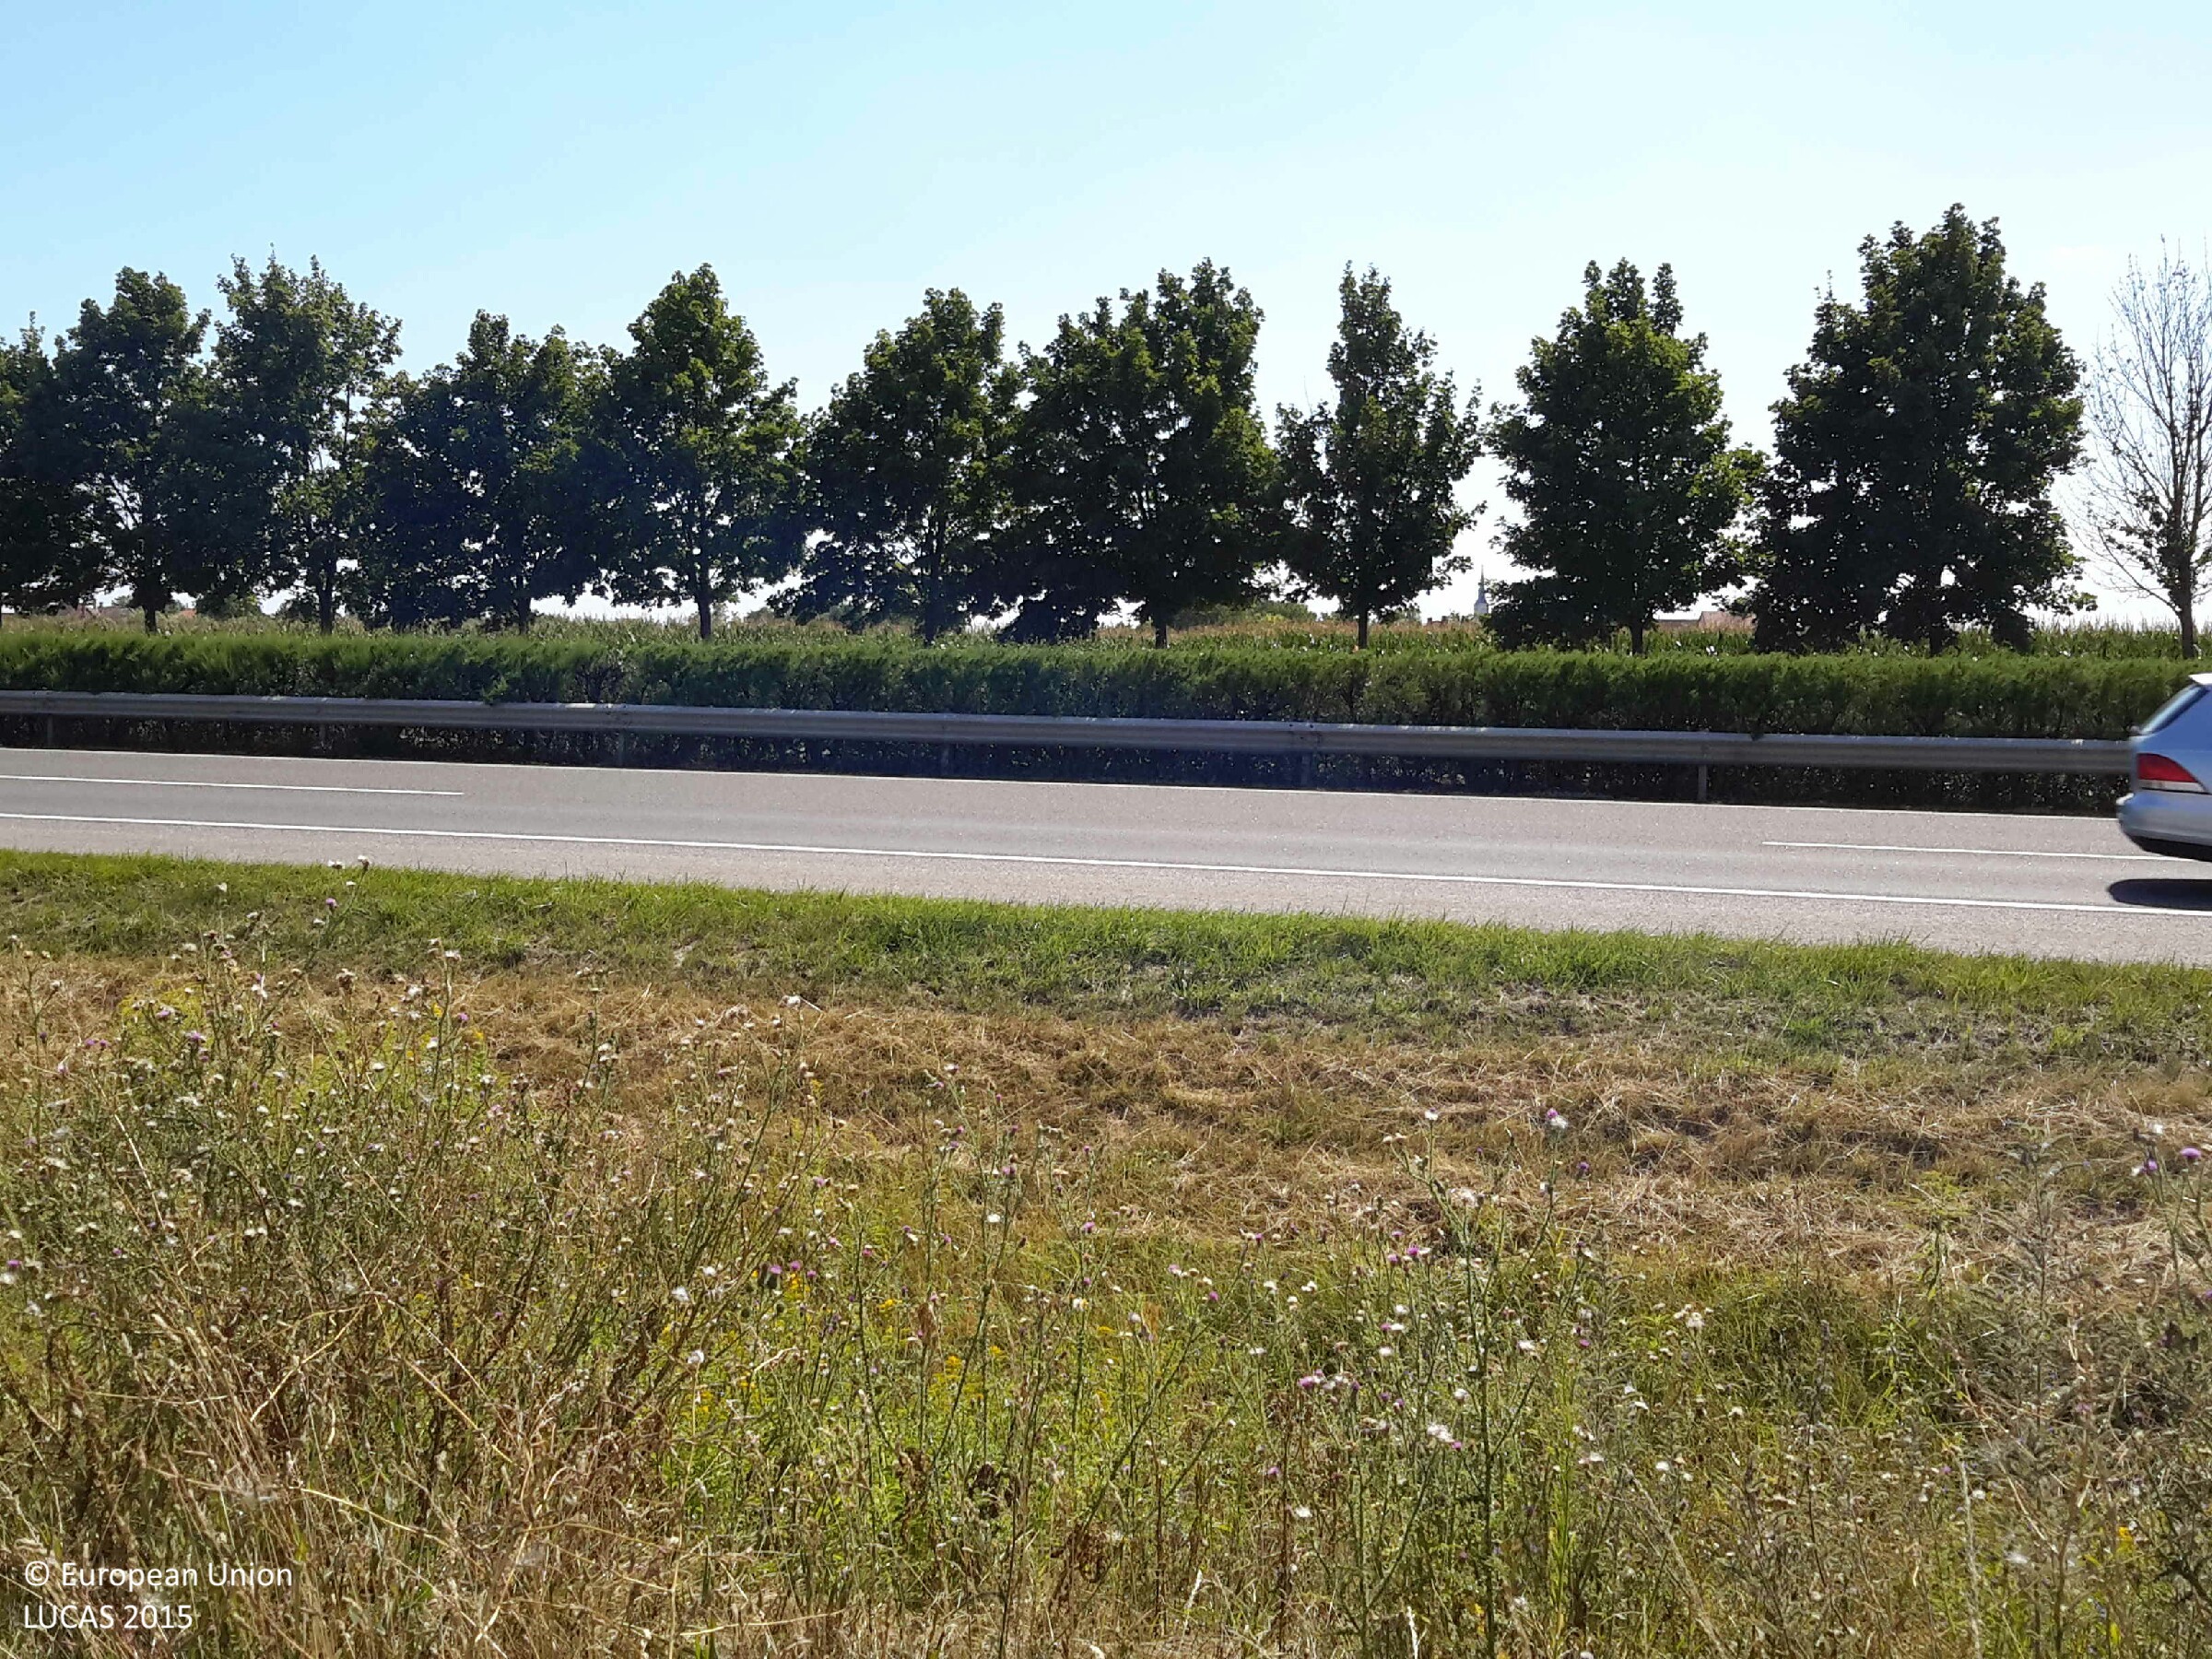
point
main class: Grassland
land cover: Grassland without tree/shrub cover
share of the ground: > 75 %
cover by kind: herbaceous plants 95 %, shrubs 5 %
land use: Agriculture (excluding fallow land and kitchen gardens)
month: July
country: HU
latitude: 47.7373
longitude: 17.4361
